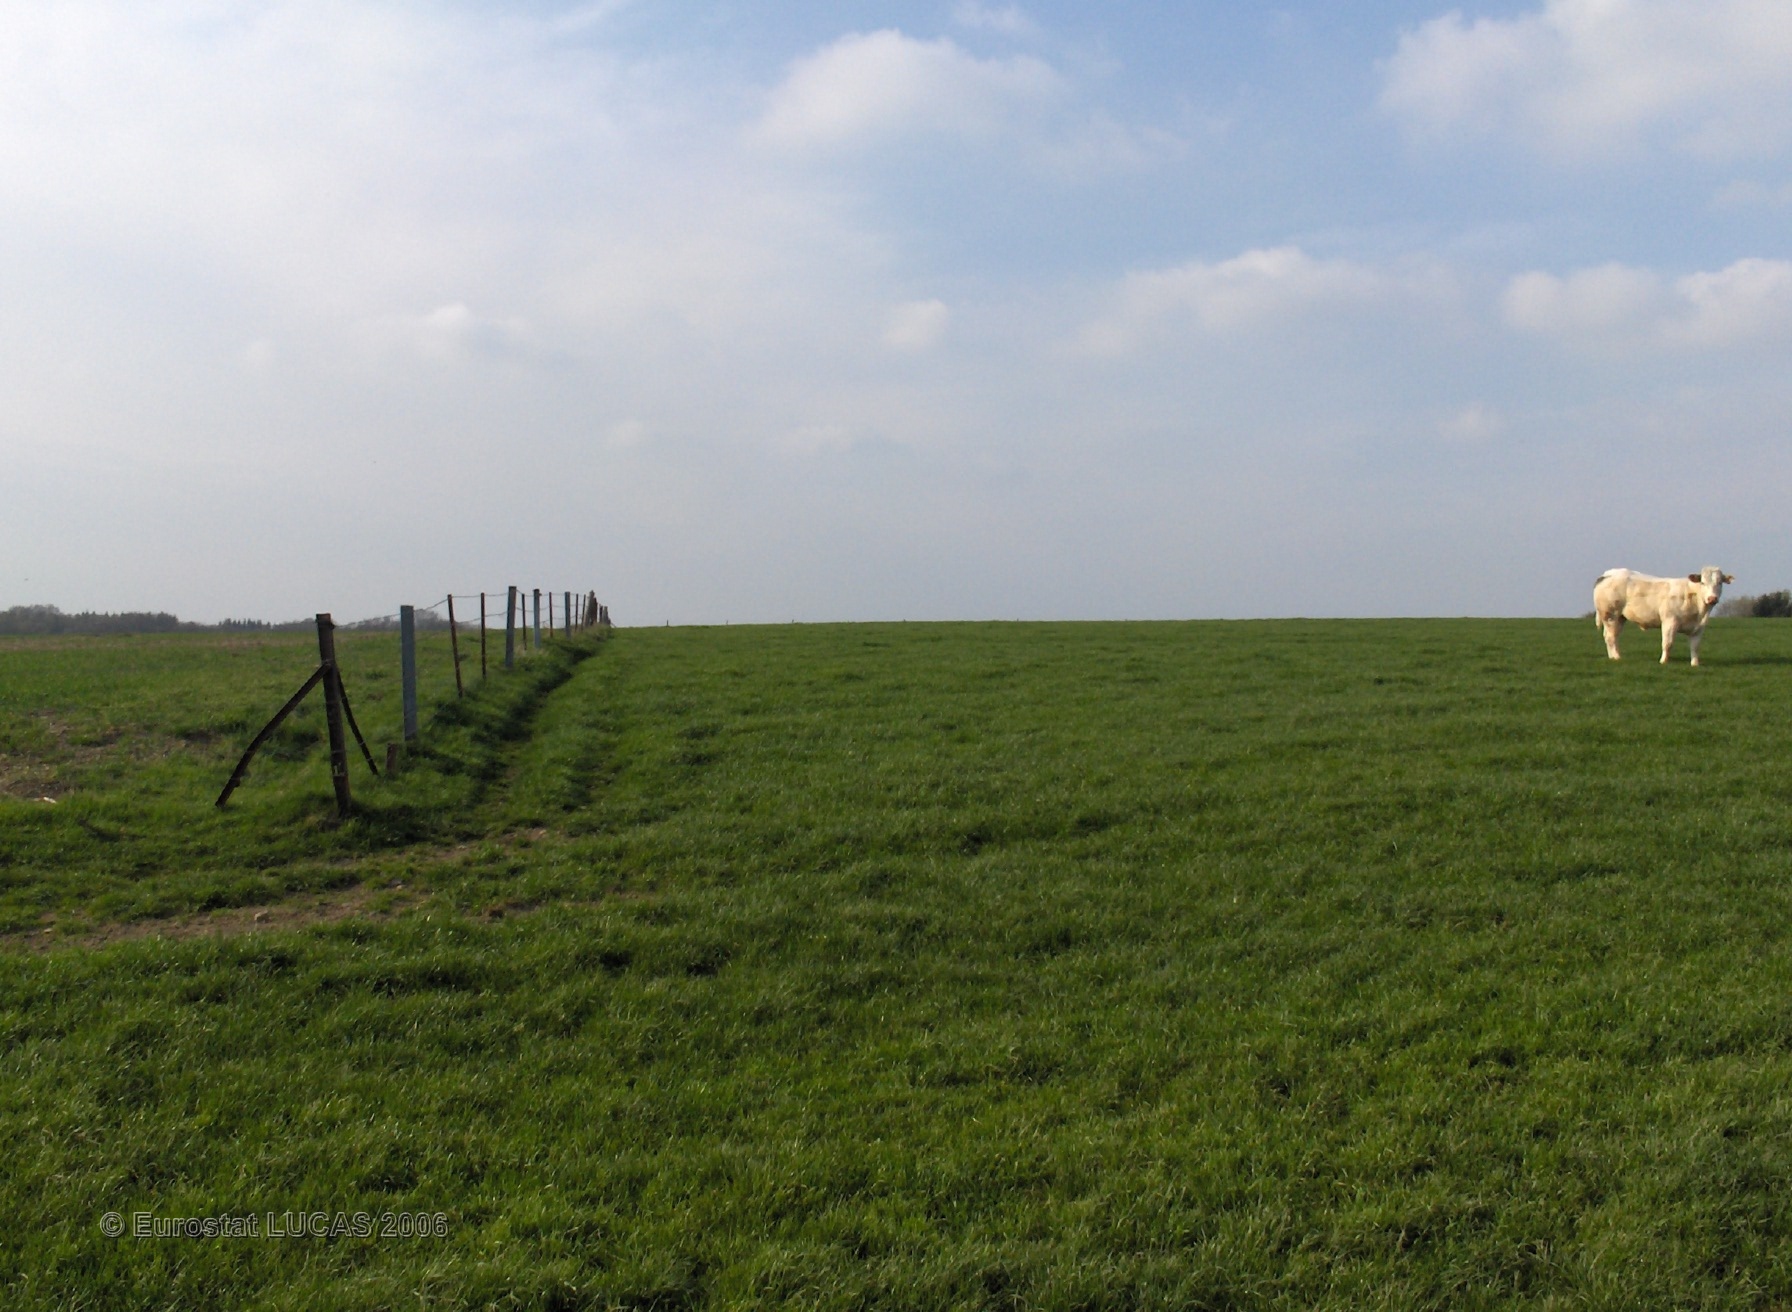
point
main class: Grassland
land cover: Grassland without tree/shrub cover
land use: Agriculture (excluding fallow land and kitchen gardens)
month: April
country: BE
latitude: 50.2531
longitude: 4.5684
